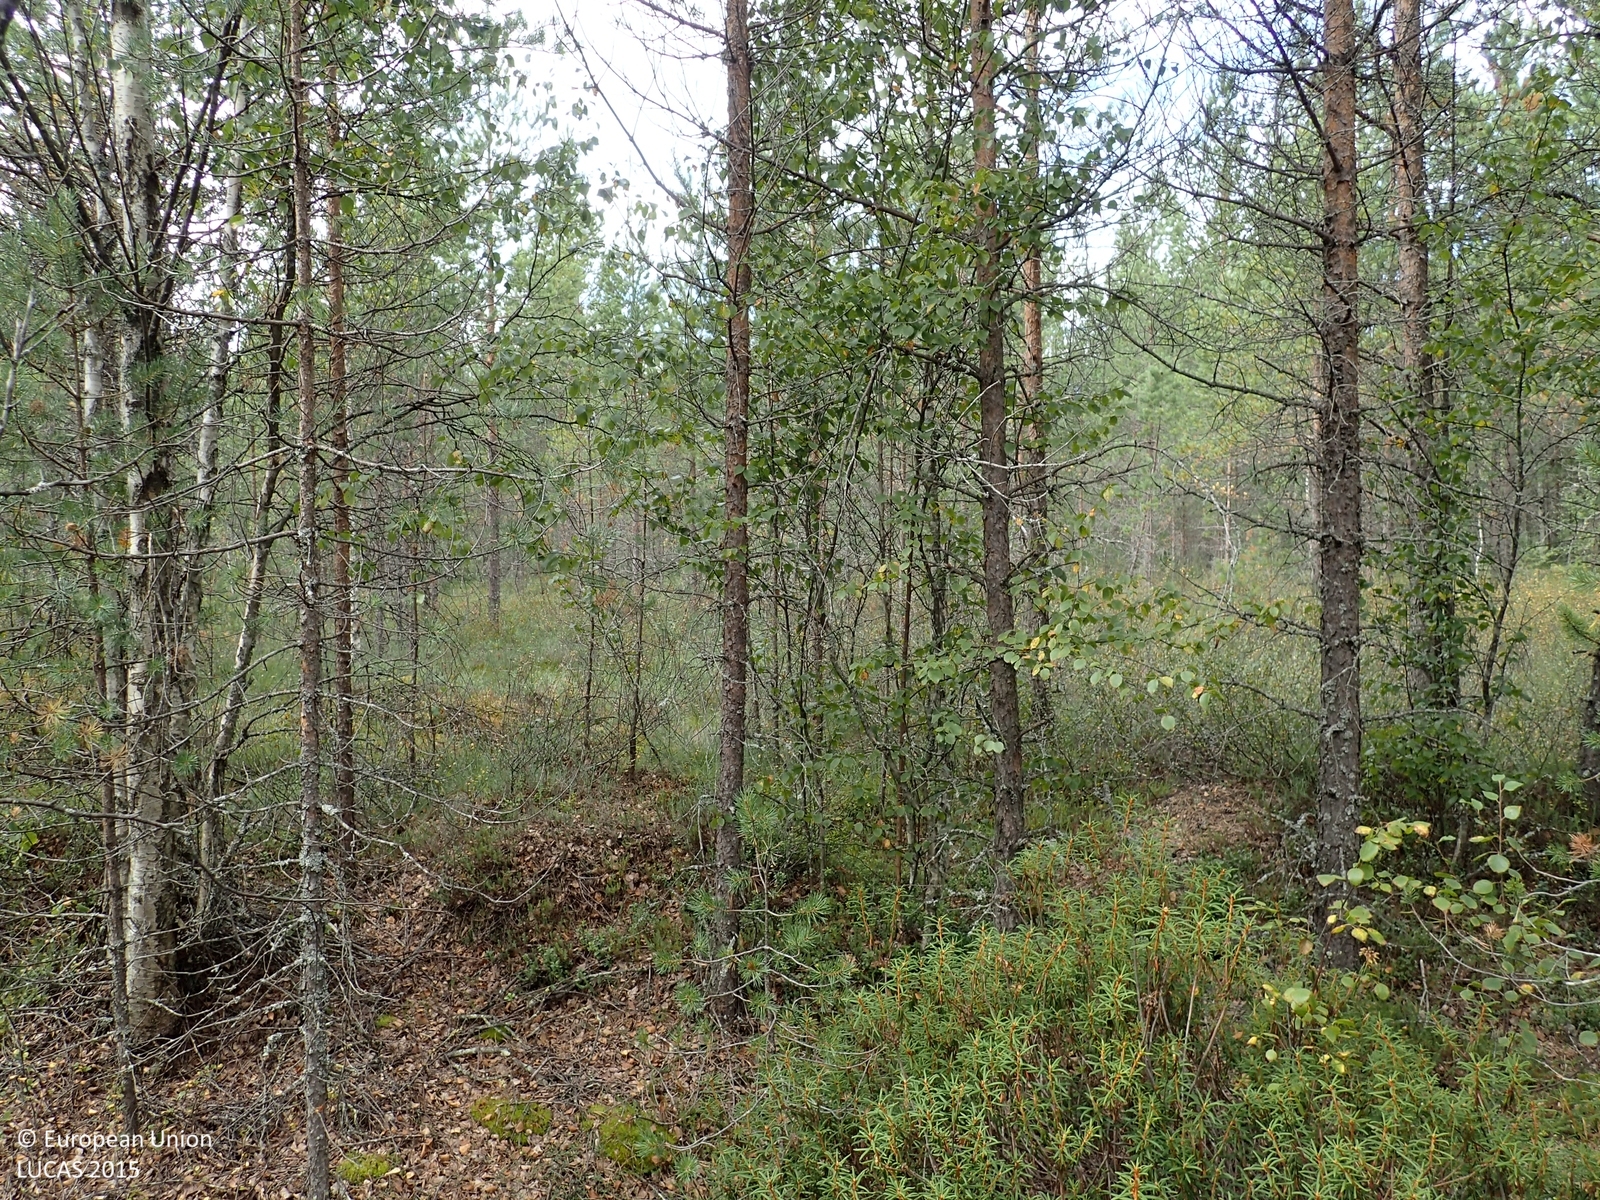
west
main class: Woodland
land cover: Pine dominated coniferous woodland
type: boreal forest
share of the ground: 50 - 75 %
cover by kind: coniferous forest trees 65 %, shrubs 25 %, broadleaved forest trees 5 %, herbaceous plants 5 %
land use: Forestry
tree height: < 5 m
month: August
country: FI
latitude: 62.2456
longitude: 23.0199
